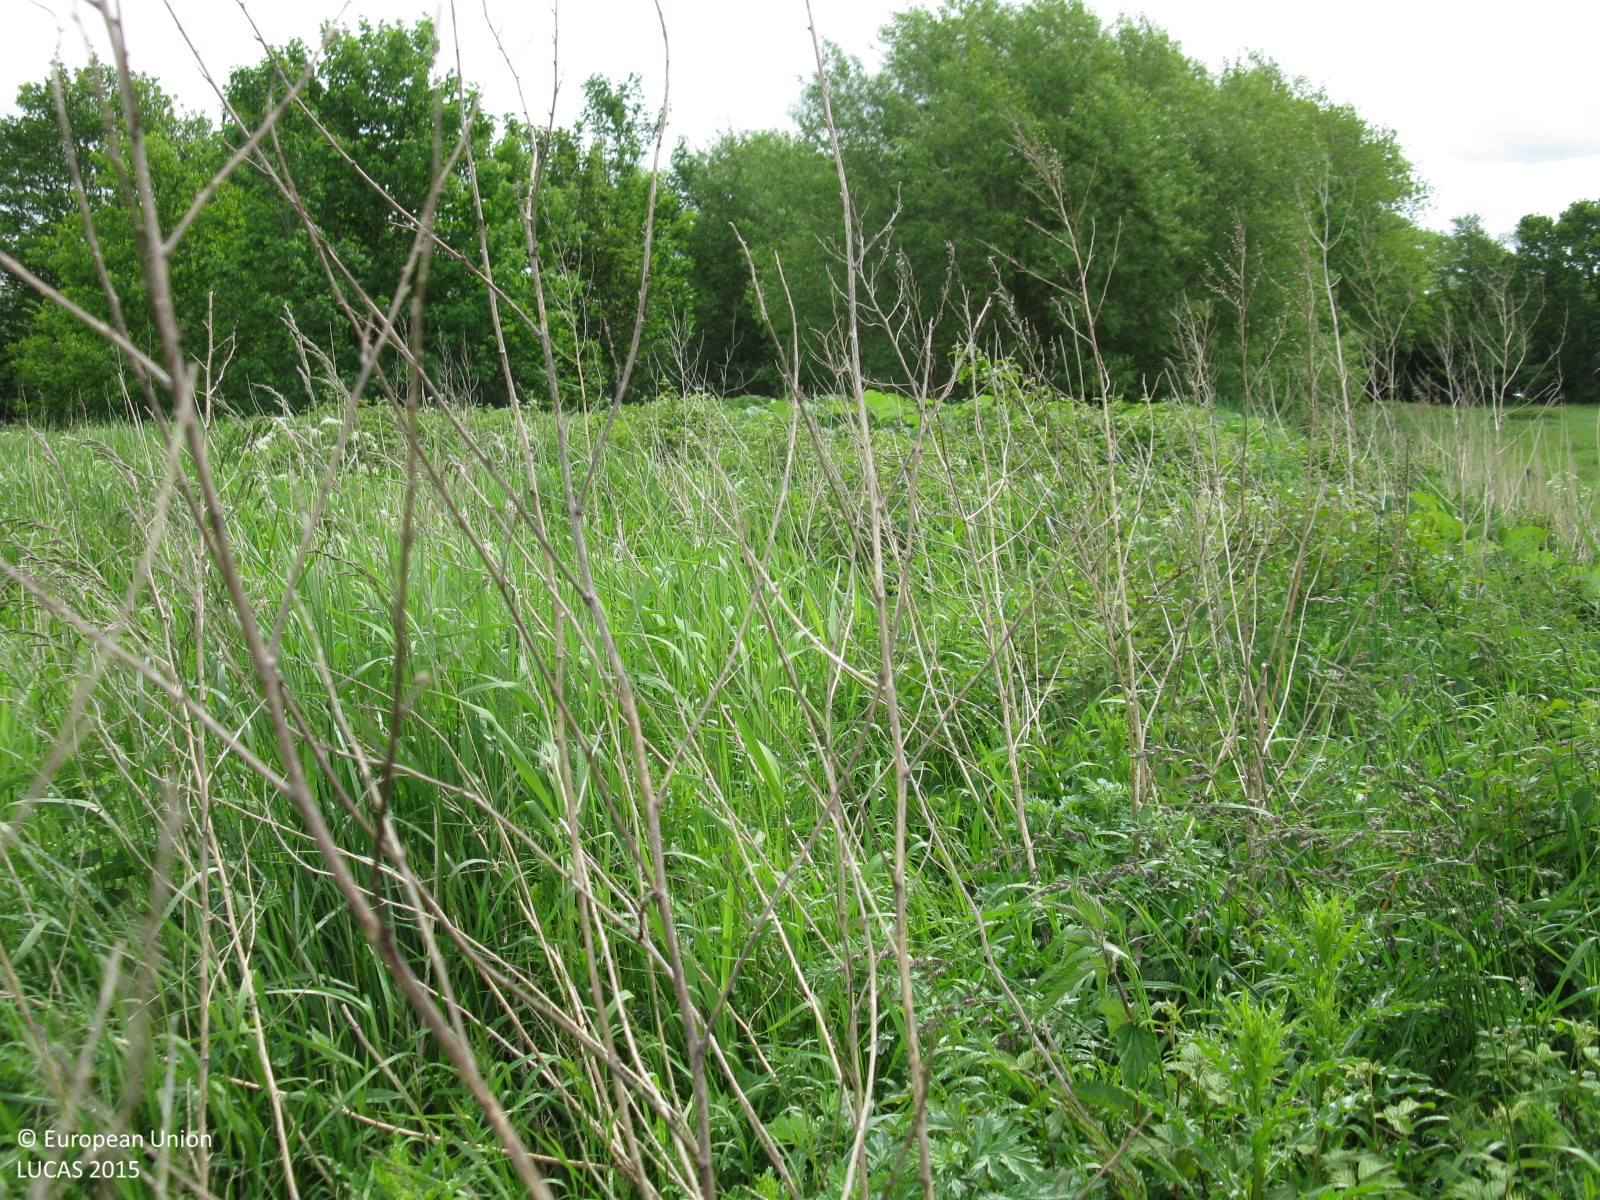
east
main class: Grassland
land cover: Grassland without tree/shrub cover
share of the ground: > 75 %
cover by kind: herbaceous plants 100 %
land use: Agriculture (excluding fallow land and kitchen gardens)
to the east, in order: Grassland without tree/shrub cover; Fences; Ditches and canals; Broadleaved woodland; Grassland without tree/shrub cover; Paved roads, cycling and walking lanes; Lines of trees; Ditches and canals; Grassland without tree/shrub cover; Ditches and canals; Broadleaved woodland; Artificial constructions in urban areas
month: June
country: DE
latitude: 53.1380
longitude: 7.2949
